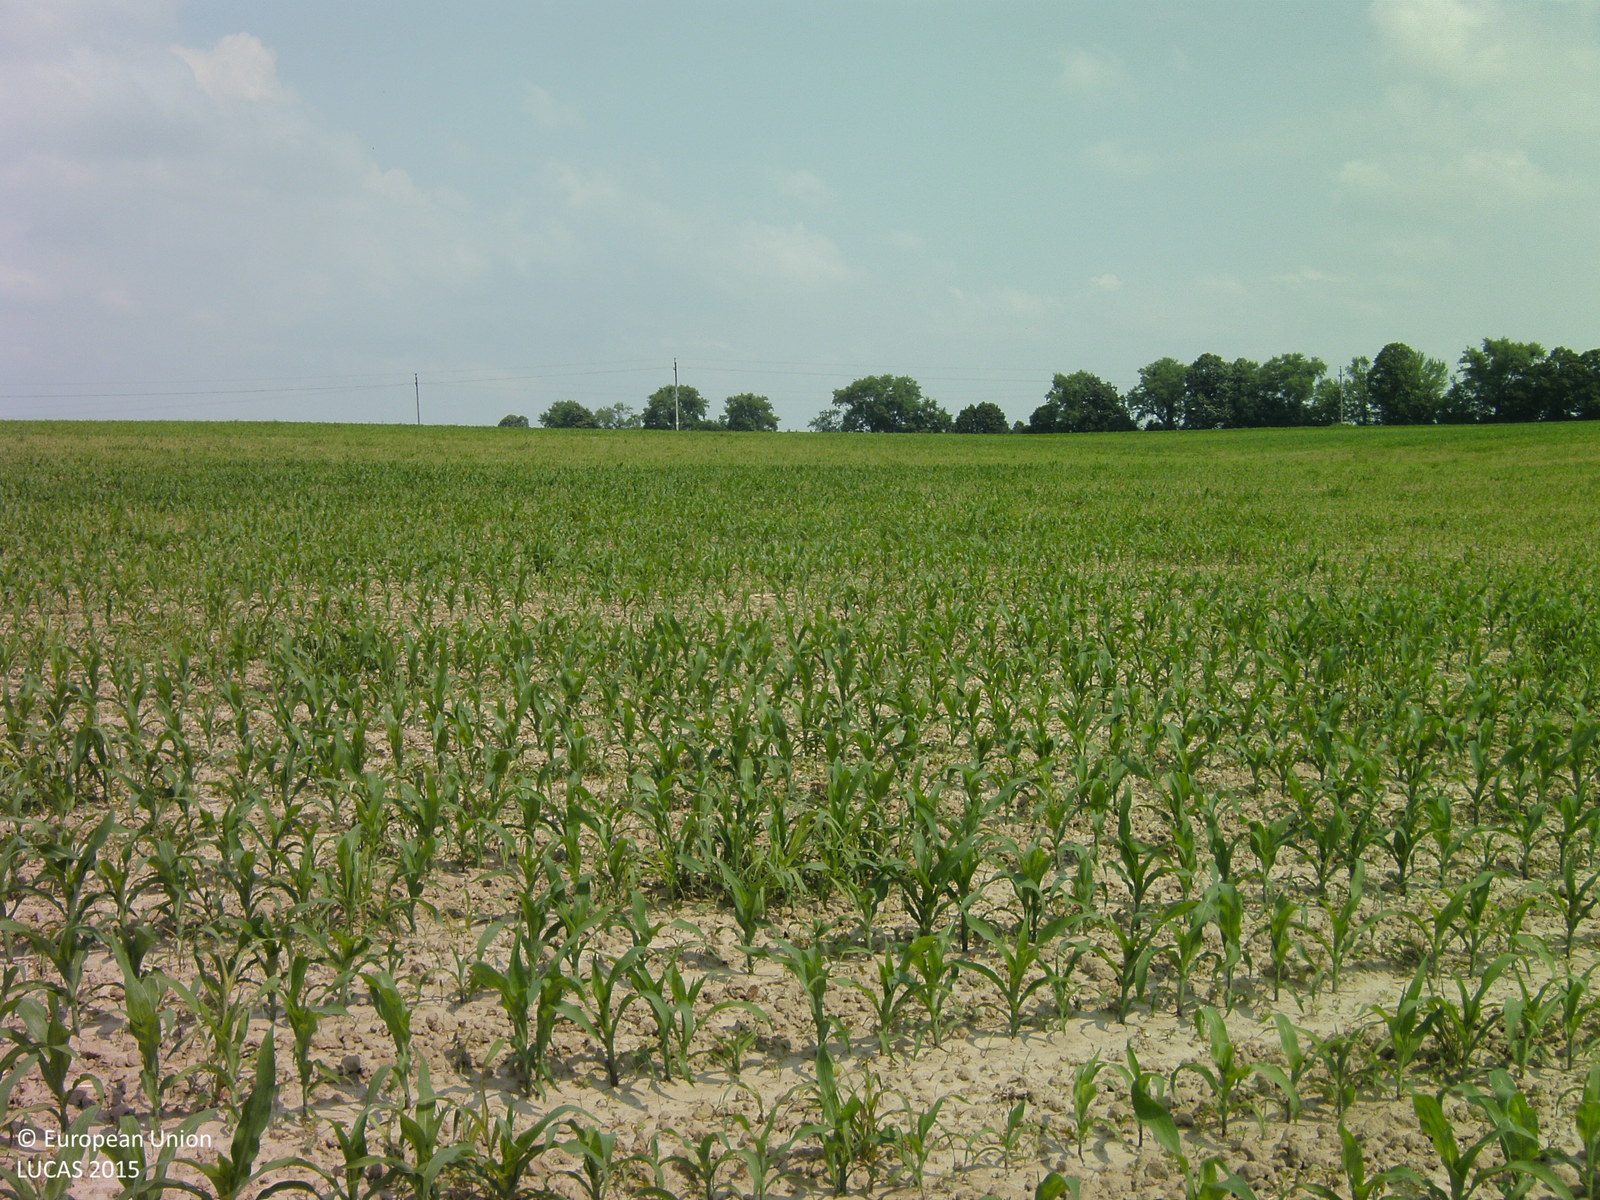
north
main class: Cropland
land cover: Maize
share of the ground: 10 - 25 %
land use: Agriculture (excluding fallow land and kitchen gardens)
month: June
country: HU
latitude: 46.3704
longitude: 17.8448
